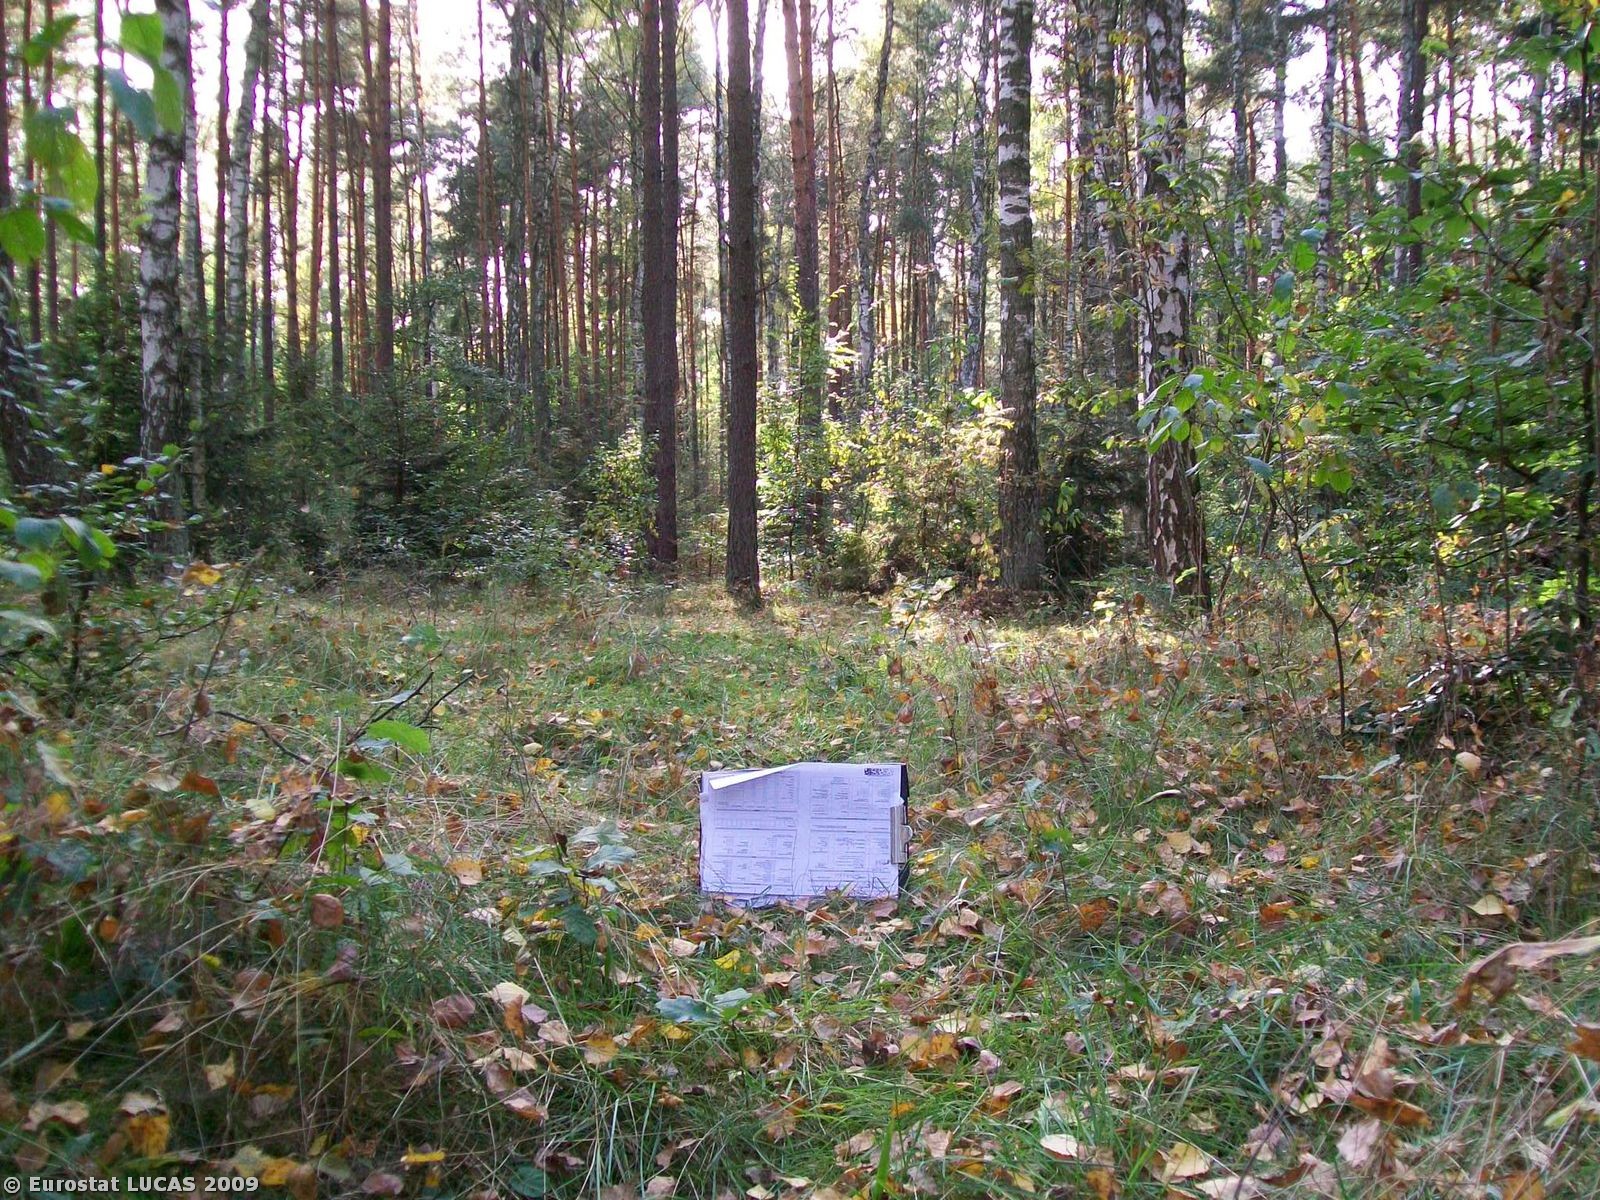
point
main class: Woodland
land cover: Mixed woodland
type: hemiboreal forest and nemoral coniferous forest and mixed broadleaved-coniferous forest
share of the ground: > 75 %
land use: Nature reserves
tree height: > 5 m
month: September
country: PL
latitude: 52.1121
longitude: 21.0701
